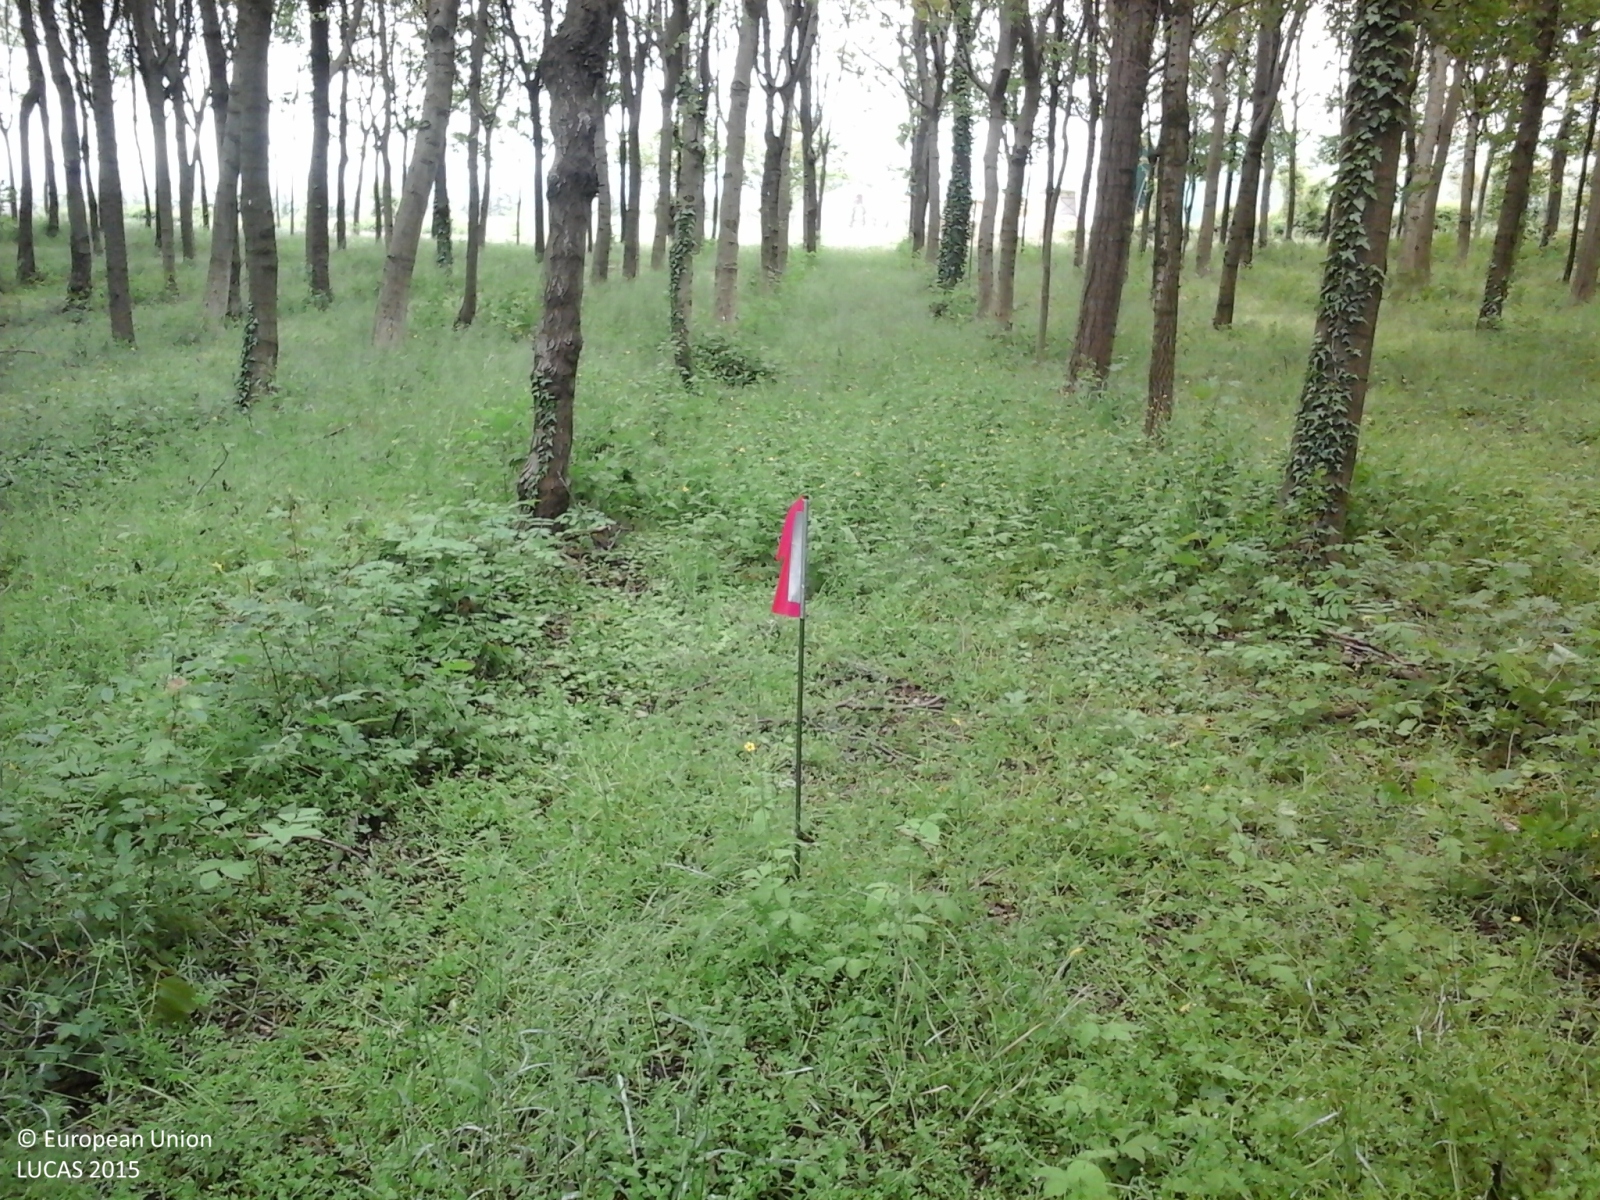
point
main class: Woodland
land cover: Broadleaved woodland
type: non-riverine alder, birch or aspen forest
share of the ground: > 75 %
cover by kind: broadleaved forest trees 100 %
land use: Forestry
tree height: > 5 m
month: April
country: IT
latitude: 45.3587
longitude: 10.5734
